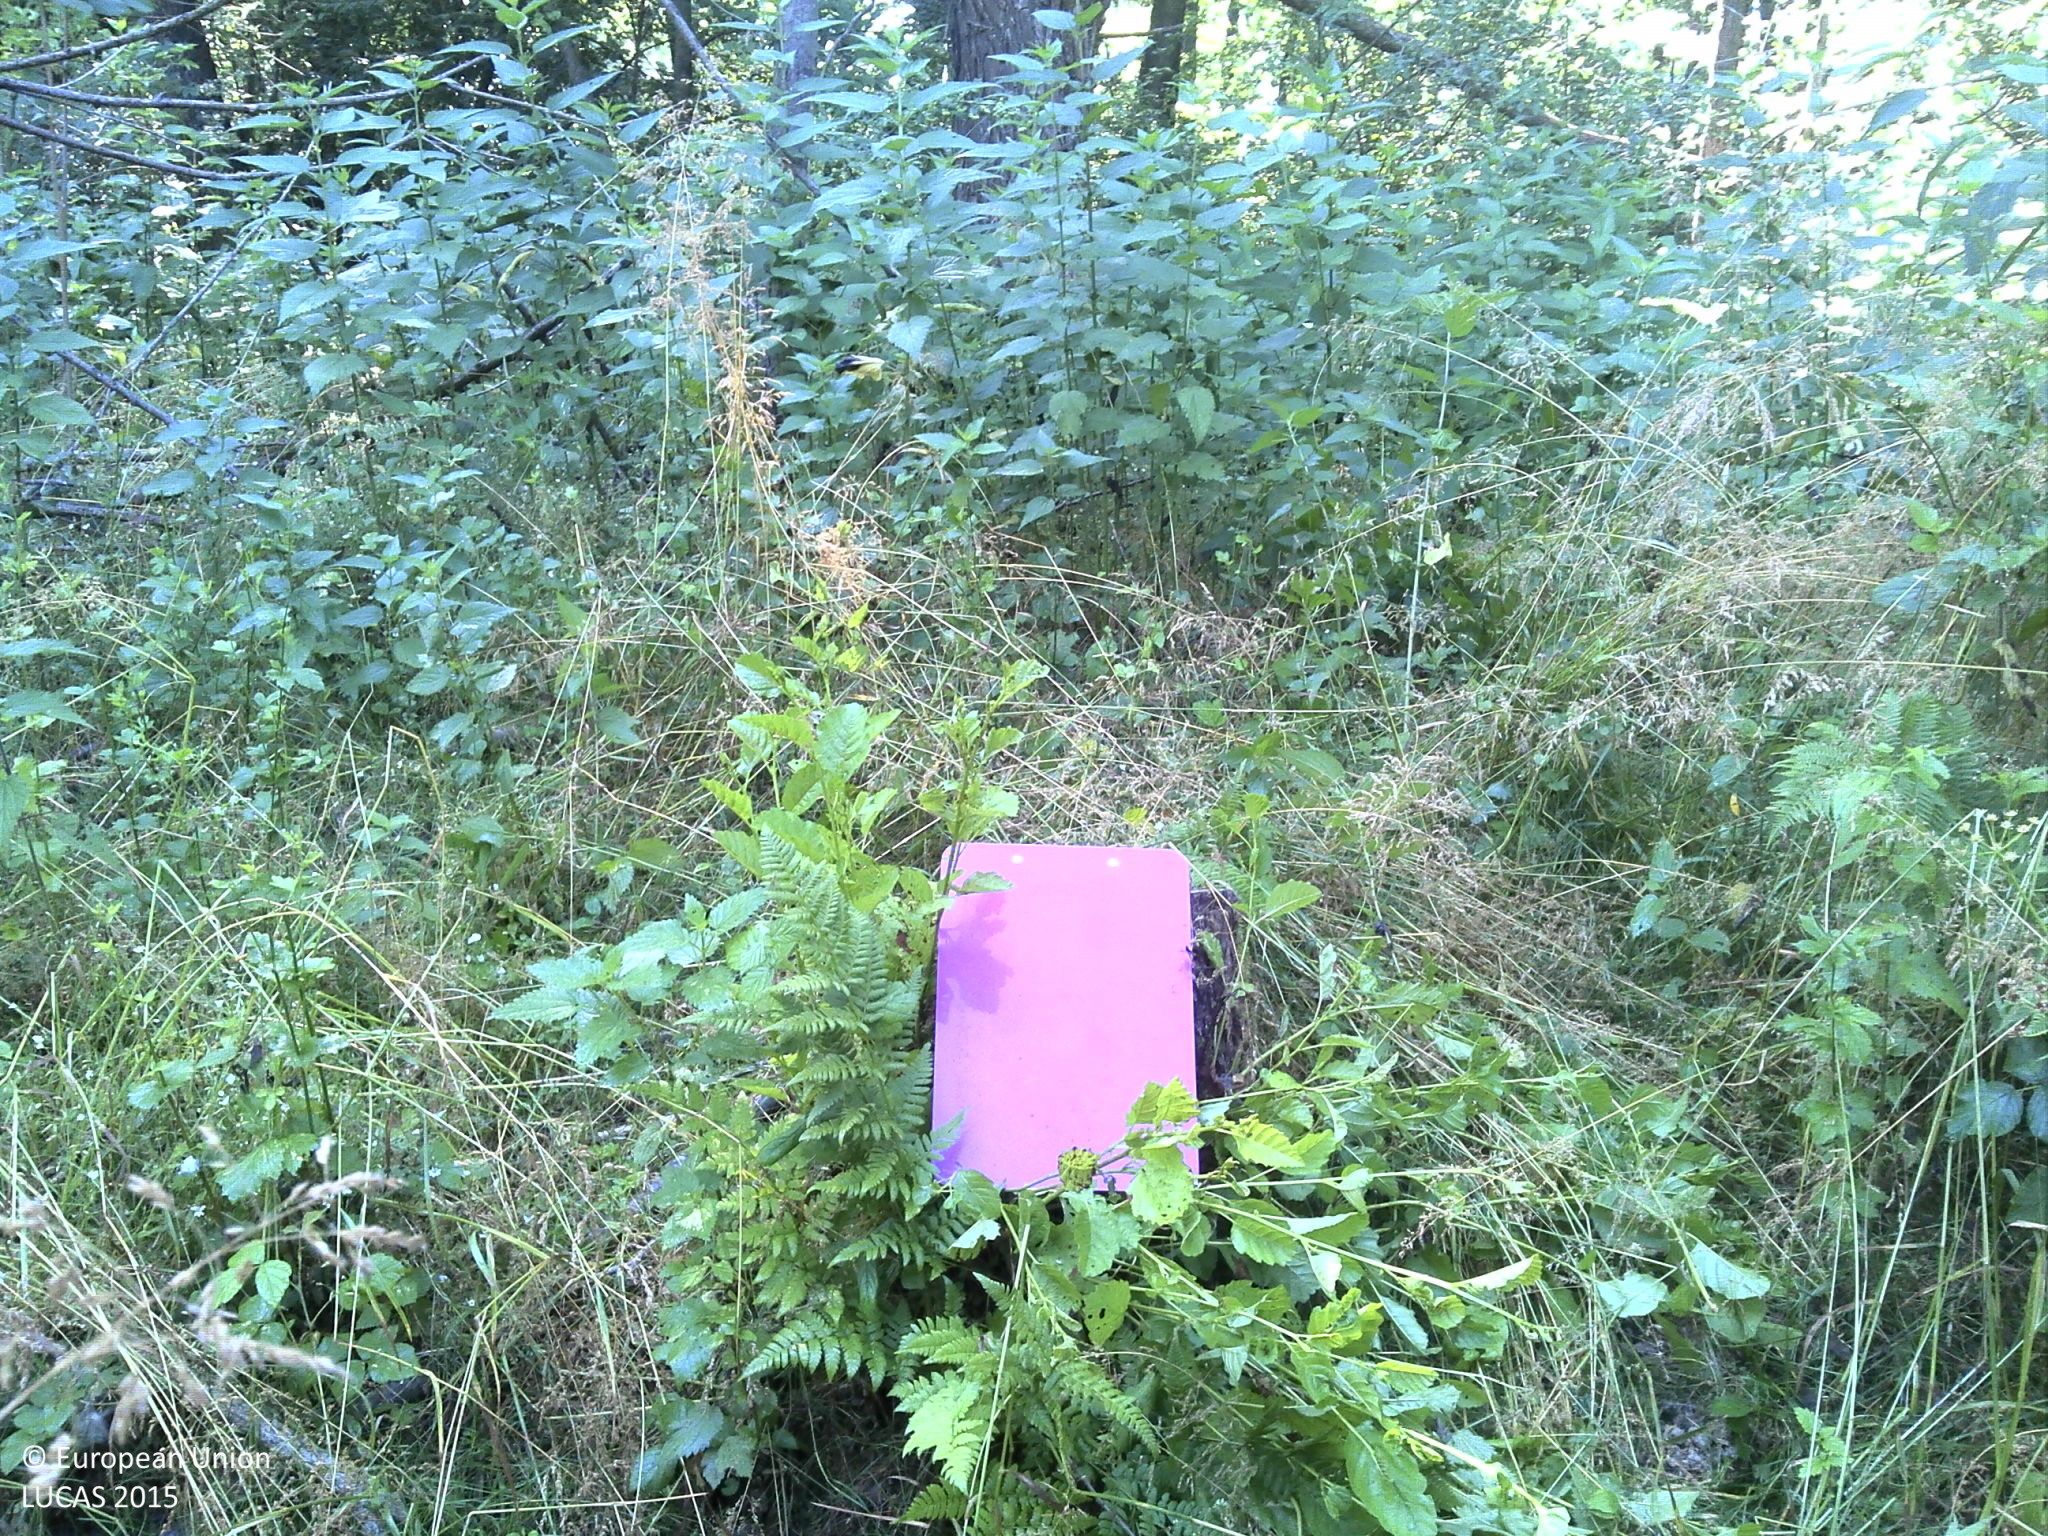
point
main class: Woodland
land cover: Broadleaved woodland
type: mesophytic deciduous forest
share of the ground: > 75 %
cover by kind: broadleaved forest trees 95 %, shrubs 5 %
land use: Forestry
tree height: > 5 m
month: June
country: HR
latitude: 45.3724
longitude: 17.8810
